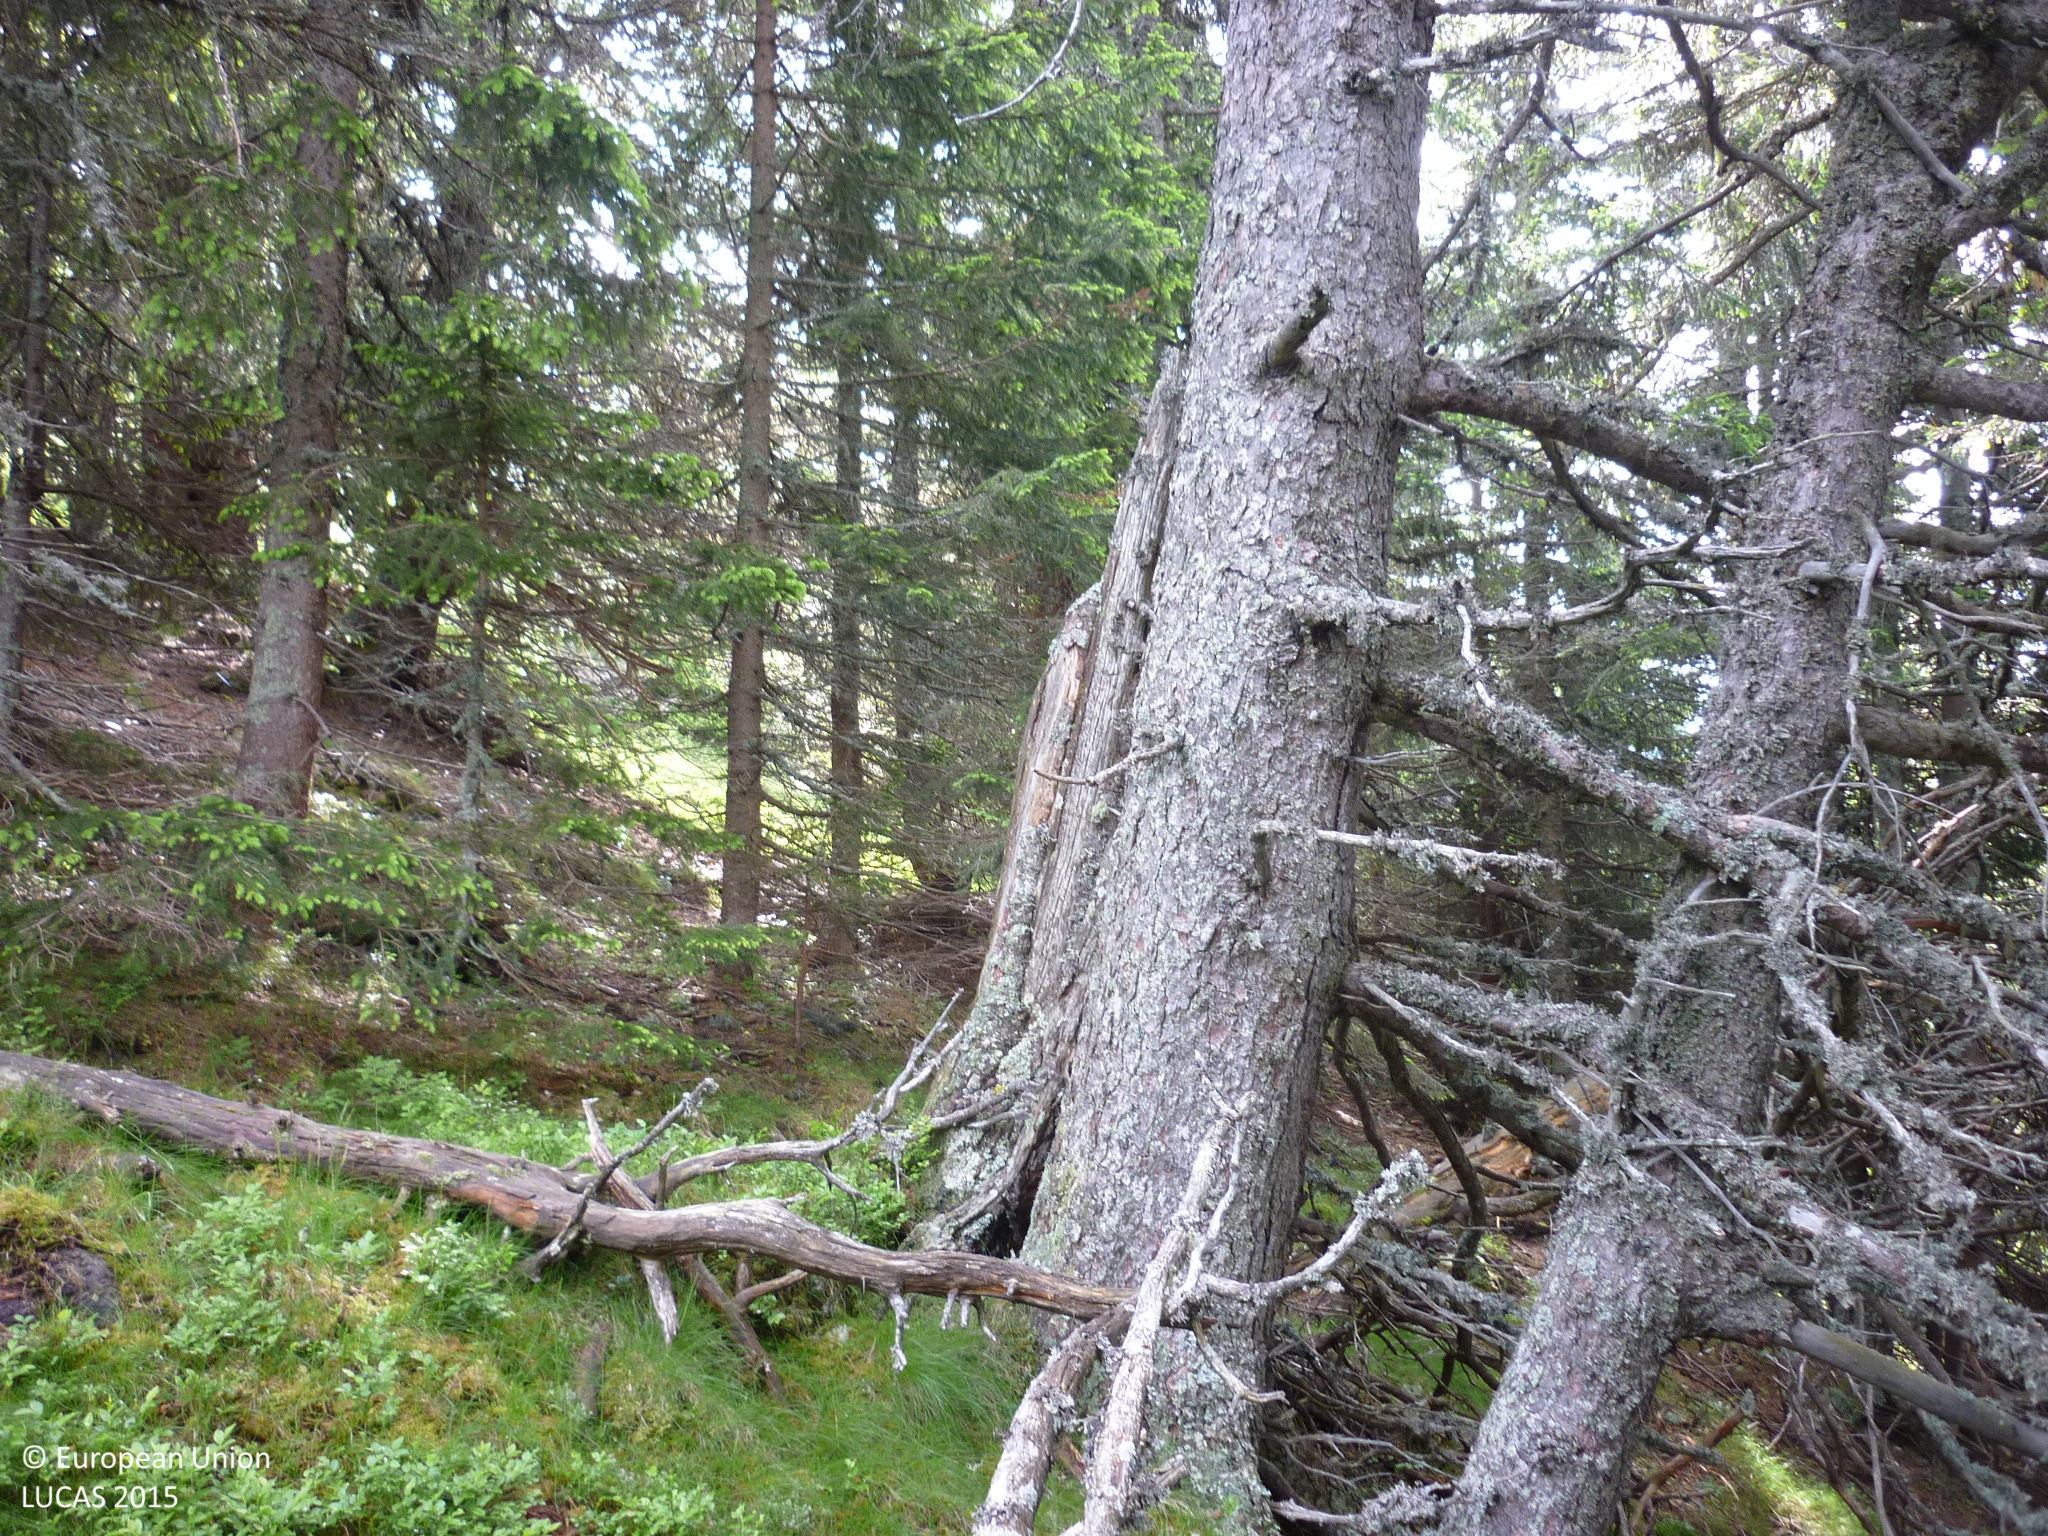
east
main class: Woodland
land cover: Spruce dominated coniferous woodland
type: alpine coniferous forest
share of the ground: 50 - 75 %
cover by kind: coniferous forest trees 60 %, herbaceous plants 20 %, shrubs 15 %, lichens and mosses 5 %
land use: Agriculture (excluding fallow land and kitchen gardens)
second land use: Forestry
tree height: > 5 m
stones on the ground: < 10 %
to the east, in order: Spruce dominated coniferous woodland; Shrubland without tree cover; Grassland with sparse tree/shrub cover; Tracks; Grassland with sparse tree/shrub cover
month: June
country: AT
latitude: 47.2260
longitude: 14.1585
